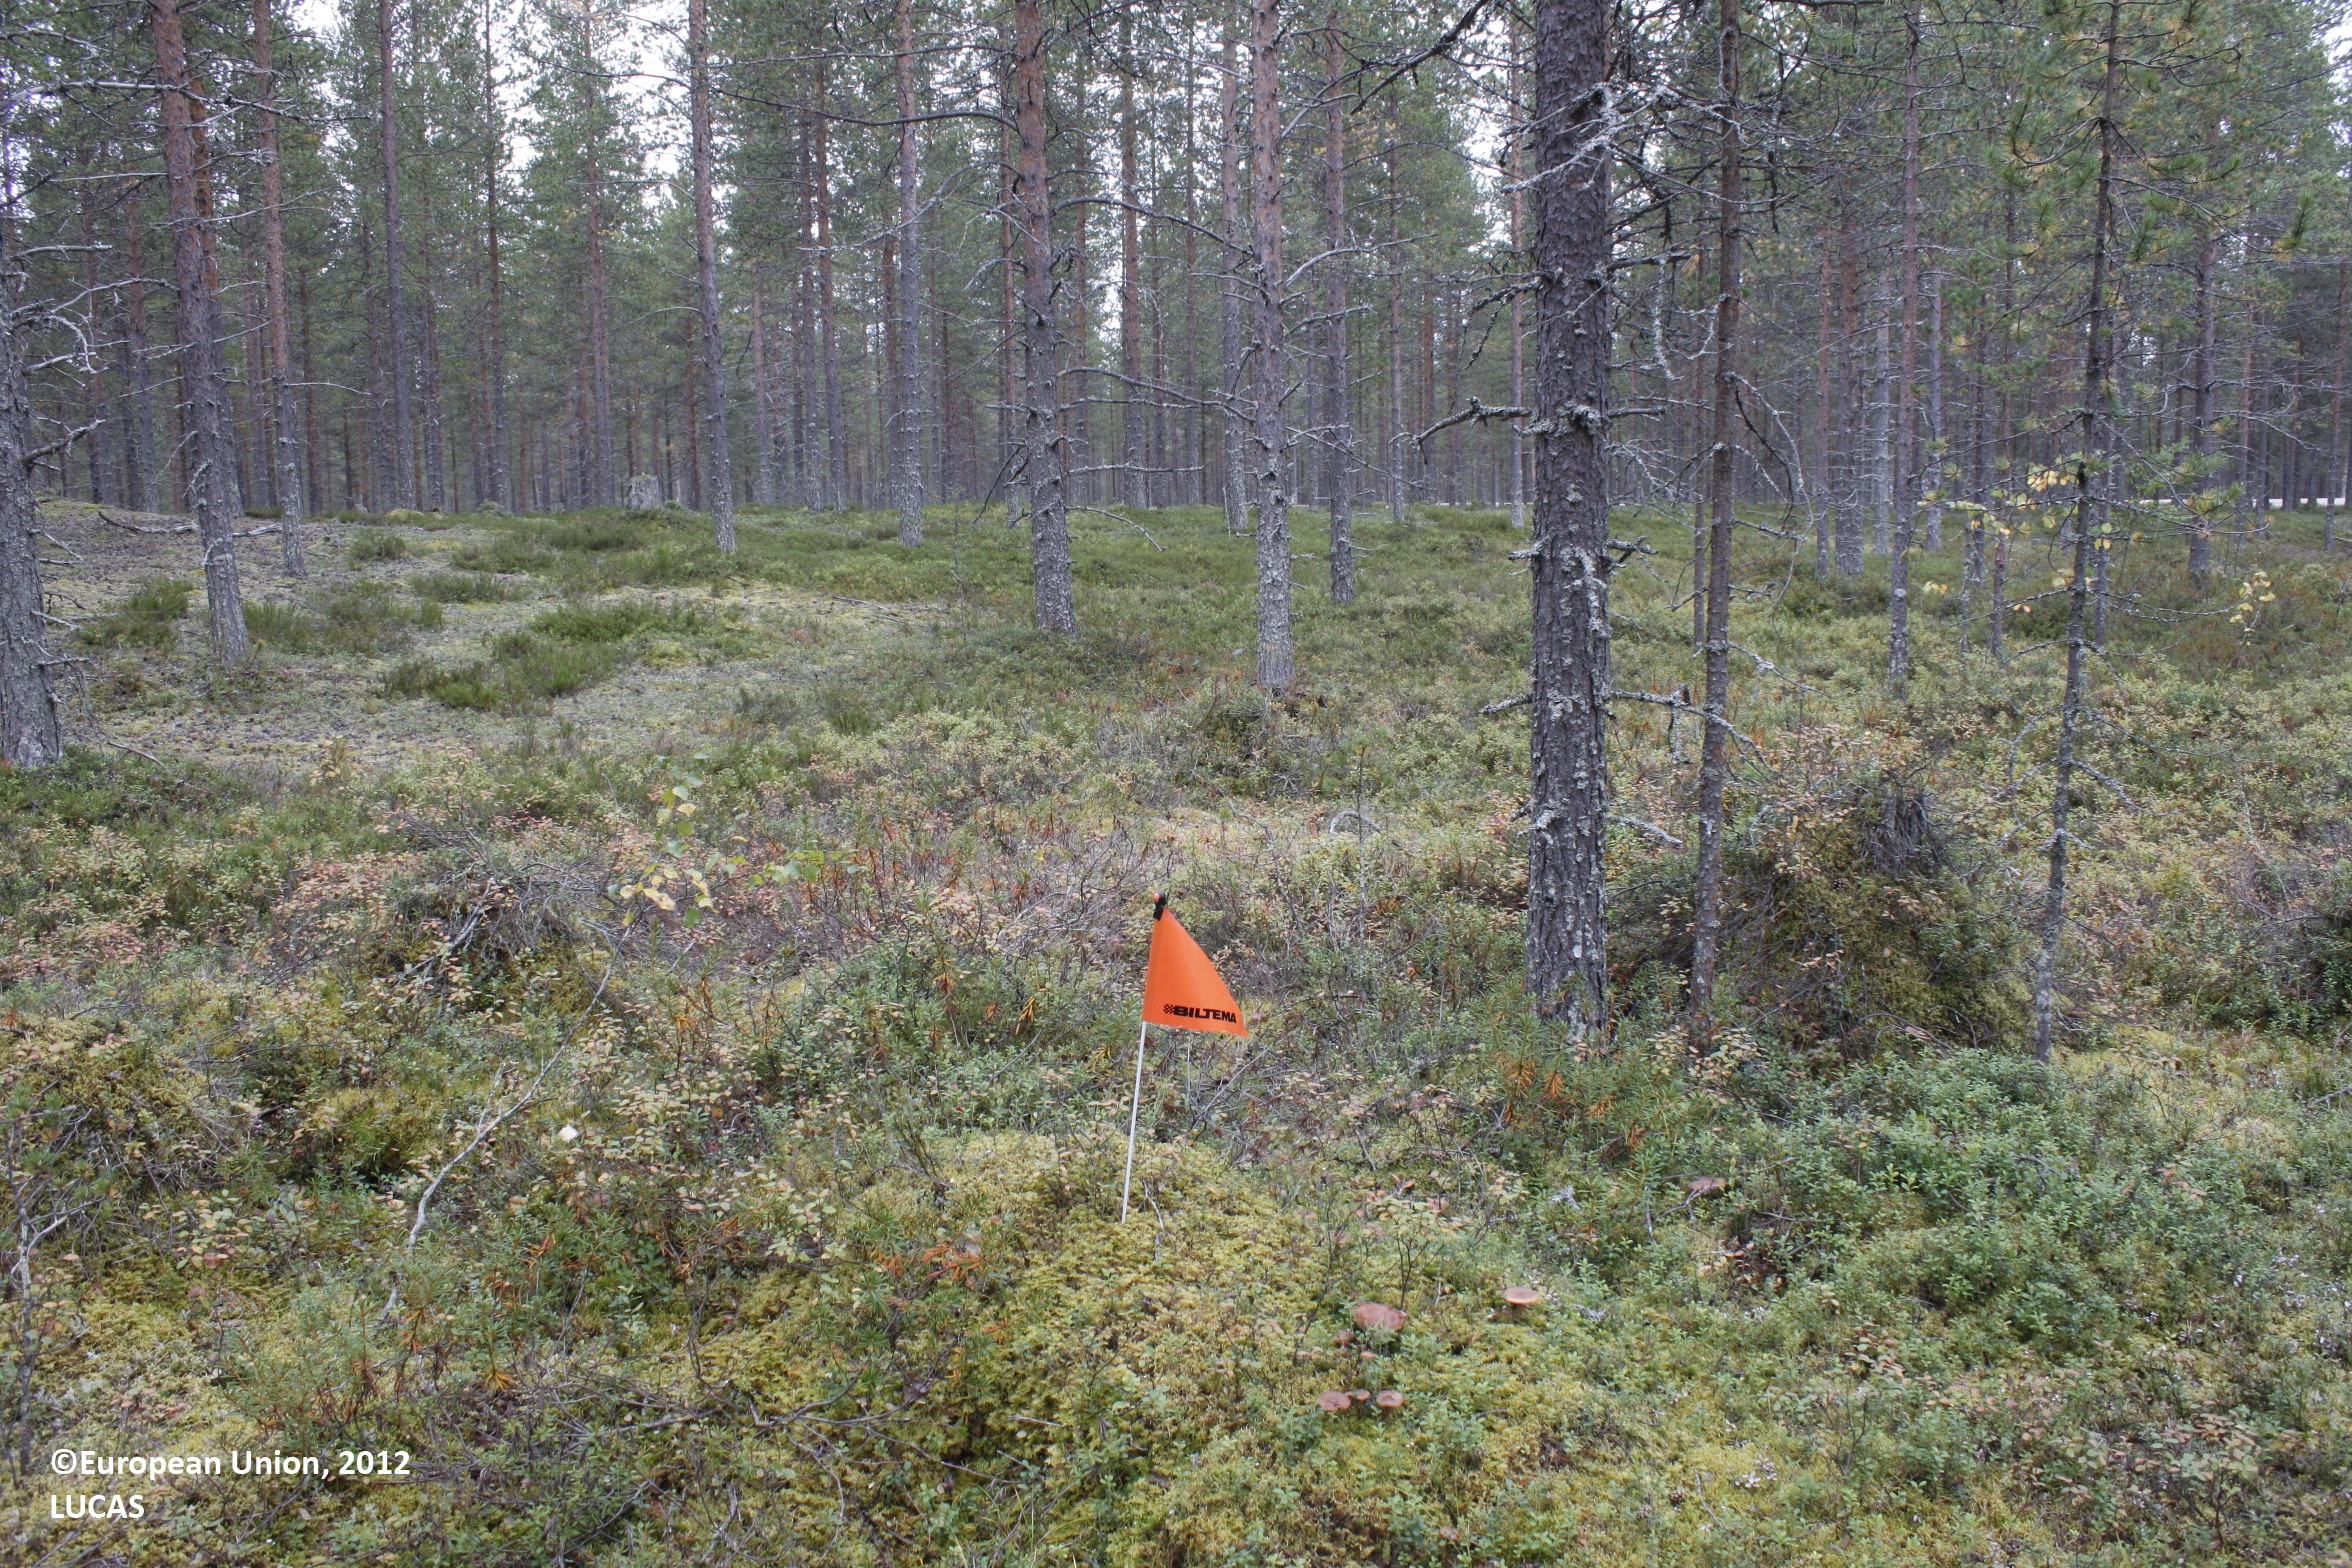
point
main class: Woodland
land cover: Pine dominated coniferous woodland
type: mire and swamp forests
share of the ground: 25 - 50 %
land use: Forestry
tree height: > 5 m
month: September
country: FI
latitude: 65.4316
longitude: 26.5499
